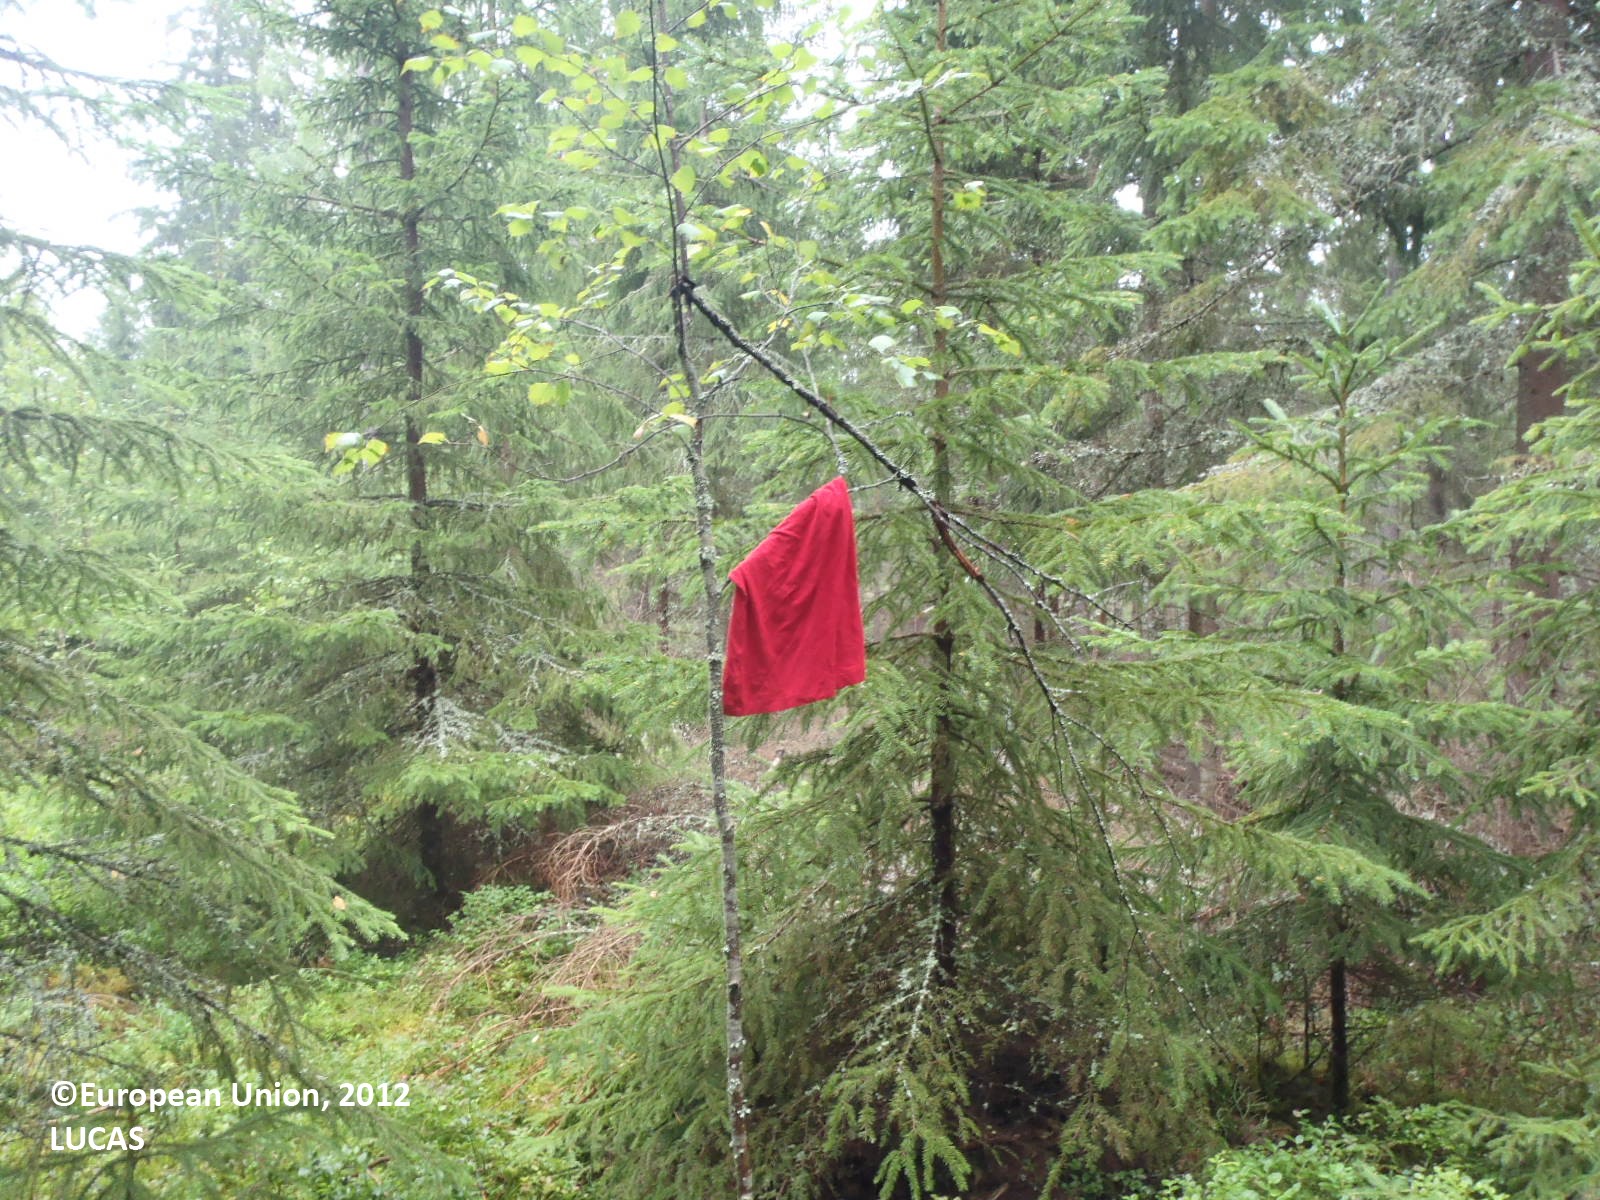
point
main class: Woodland
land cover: Spruce dominated mixed woodland
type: boreal forest
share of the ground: > 75 %
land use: Forestry
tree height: > 5 m
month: July
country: FI
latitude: 60.7457
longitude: 21.7437
